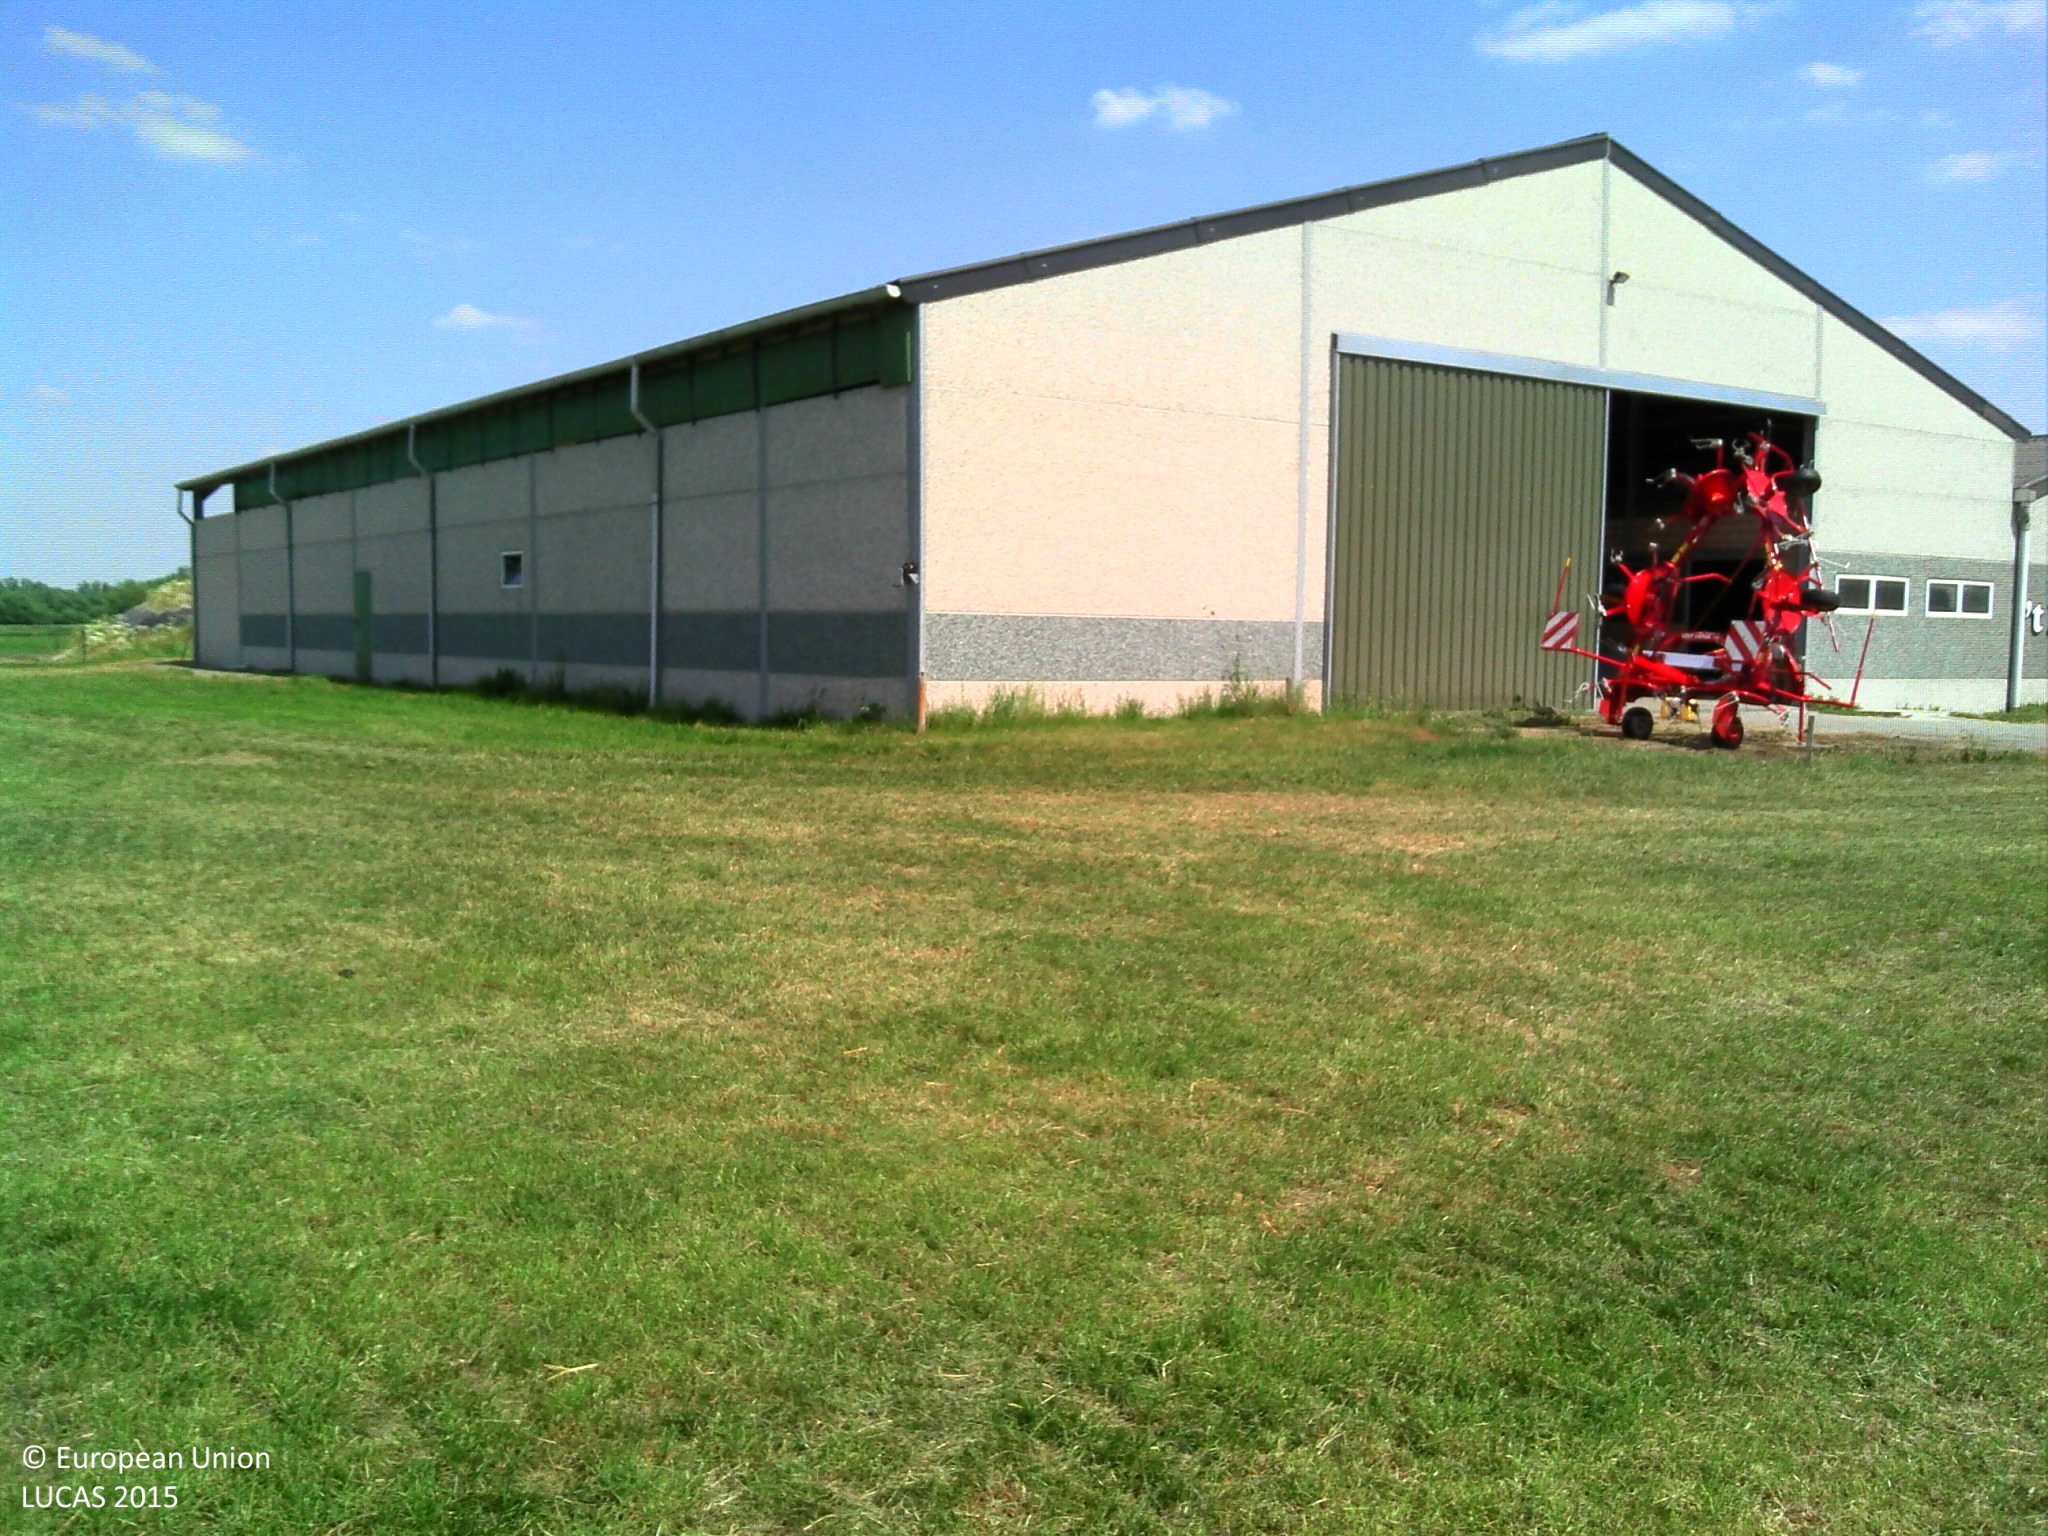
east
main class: Grassland
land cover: Grassland without tree/shrub cover
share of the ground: > 75 %
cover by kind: herbaceous plants 100 %
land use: Agriculture (excluding fallow land and kitchen gardens)
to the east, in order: Grassland without tree/shrub cover; Artificial constructions in urban areas; Grassland without tree/shrub cover; Fences; Inland fresh running water; Fences; Grassland without tree/shrub cover
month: June
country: BE
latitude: 51.0727
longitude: 4.0142
